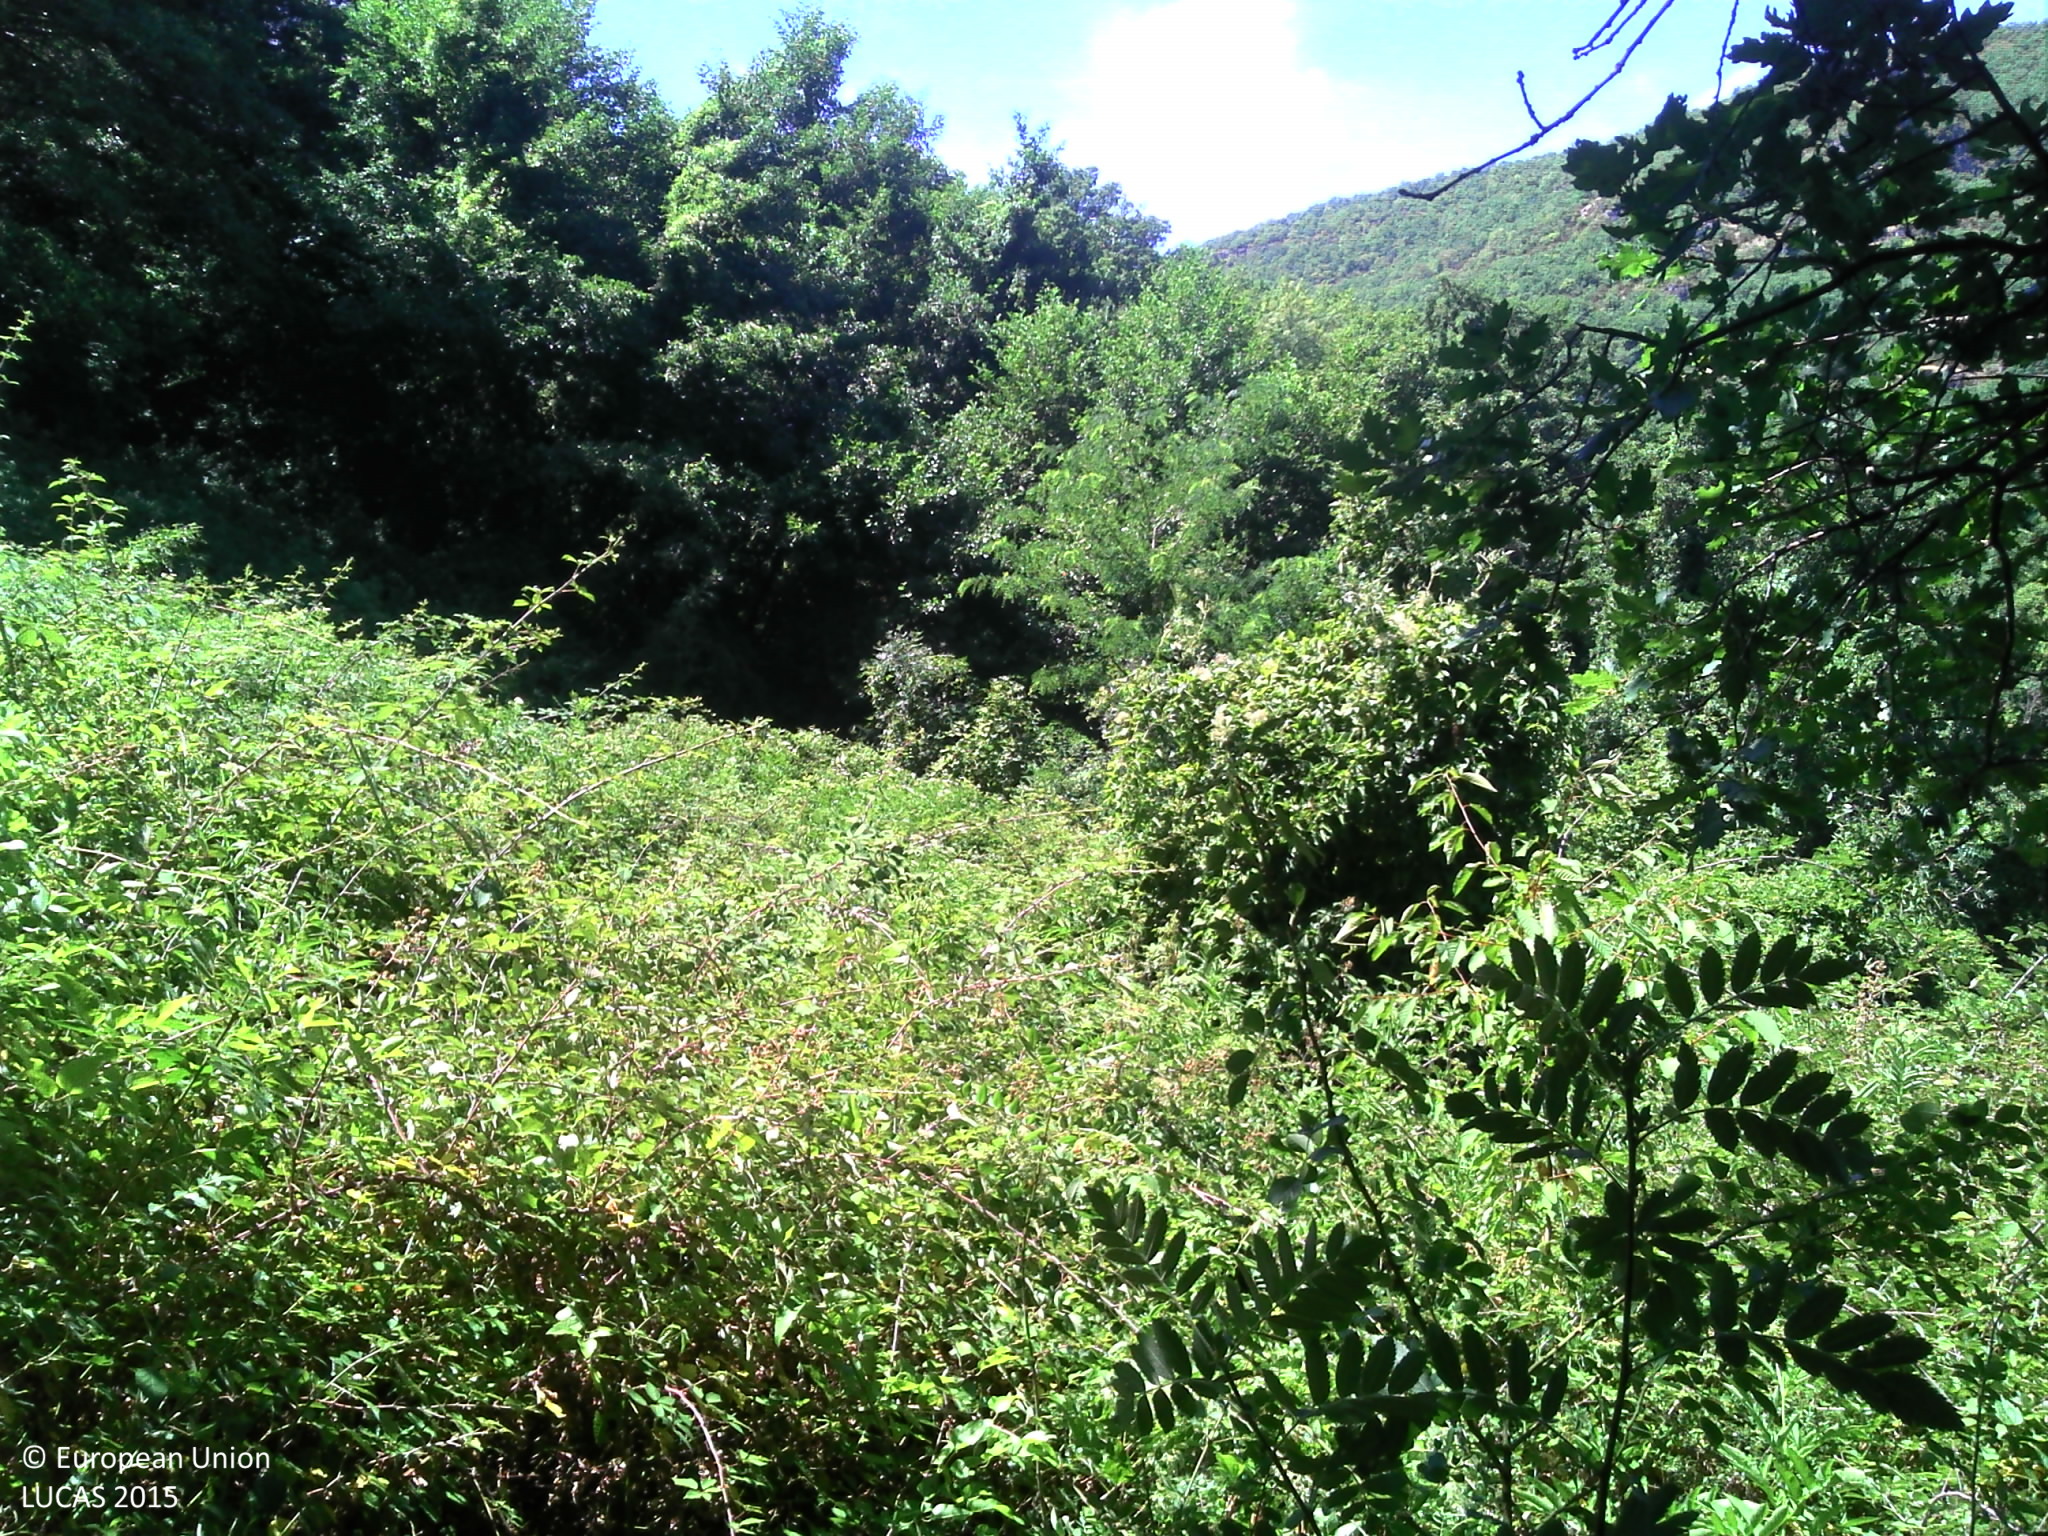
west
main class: Woodland
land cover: Broadleaved woodland
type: broadleaved evergreen forest
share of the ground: > 75 %
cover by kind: broadleaved forest trees 90 %, herbaceous plants 10 %
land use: Semi-natural and natural areas not in use
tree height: > 5 m
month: July
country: FR
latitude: 44.6988
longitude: 4.6175
